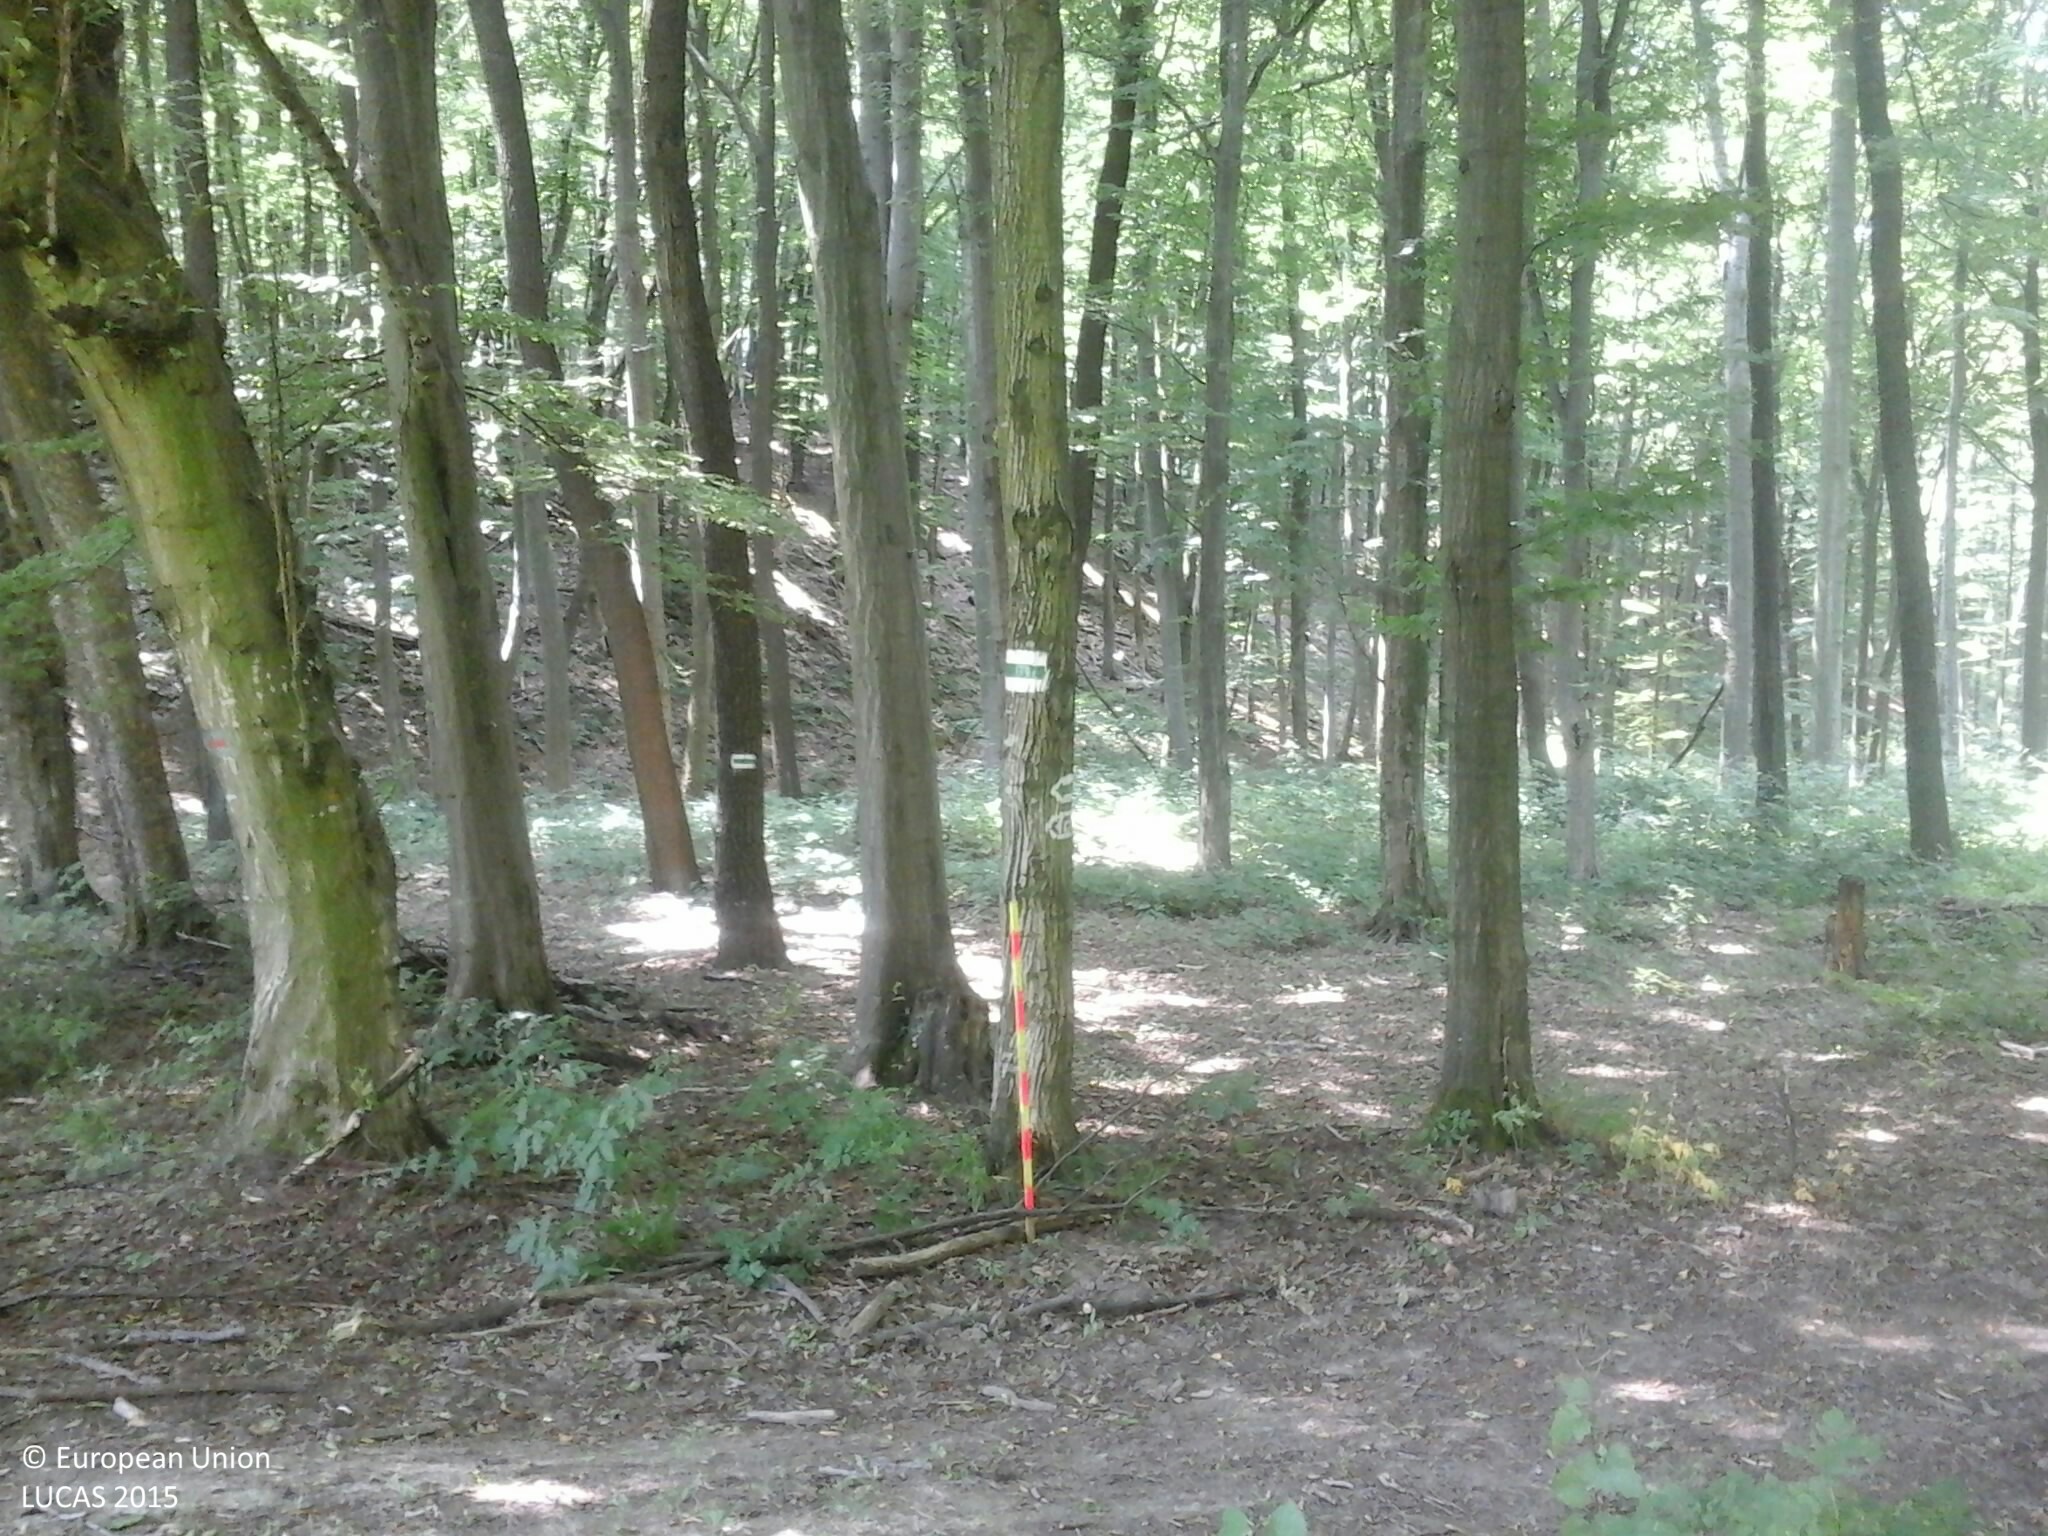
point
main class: Woodland
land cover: Broadleaved woodland
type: beech forest
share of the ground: > 75 %
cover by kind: broadleaved forest trees 95 %, unconsolidated bare surface 5 %
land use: Forestry
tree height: > 5 m
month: July
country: HU
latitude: 47.2406
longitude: 17.8163
